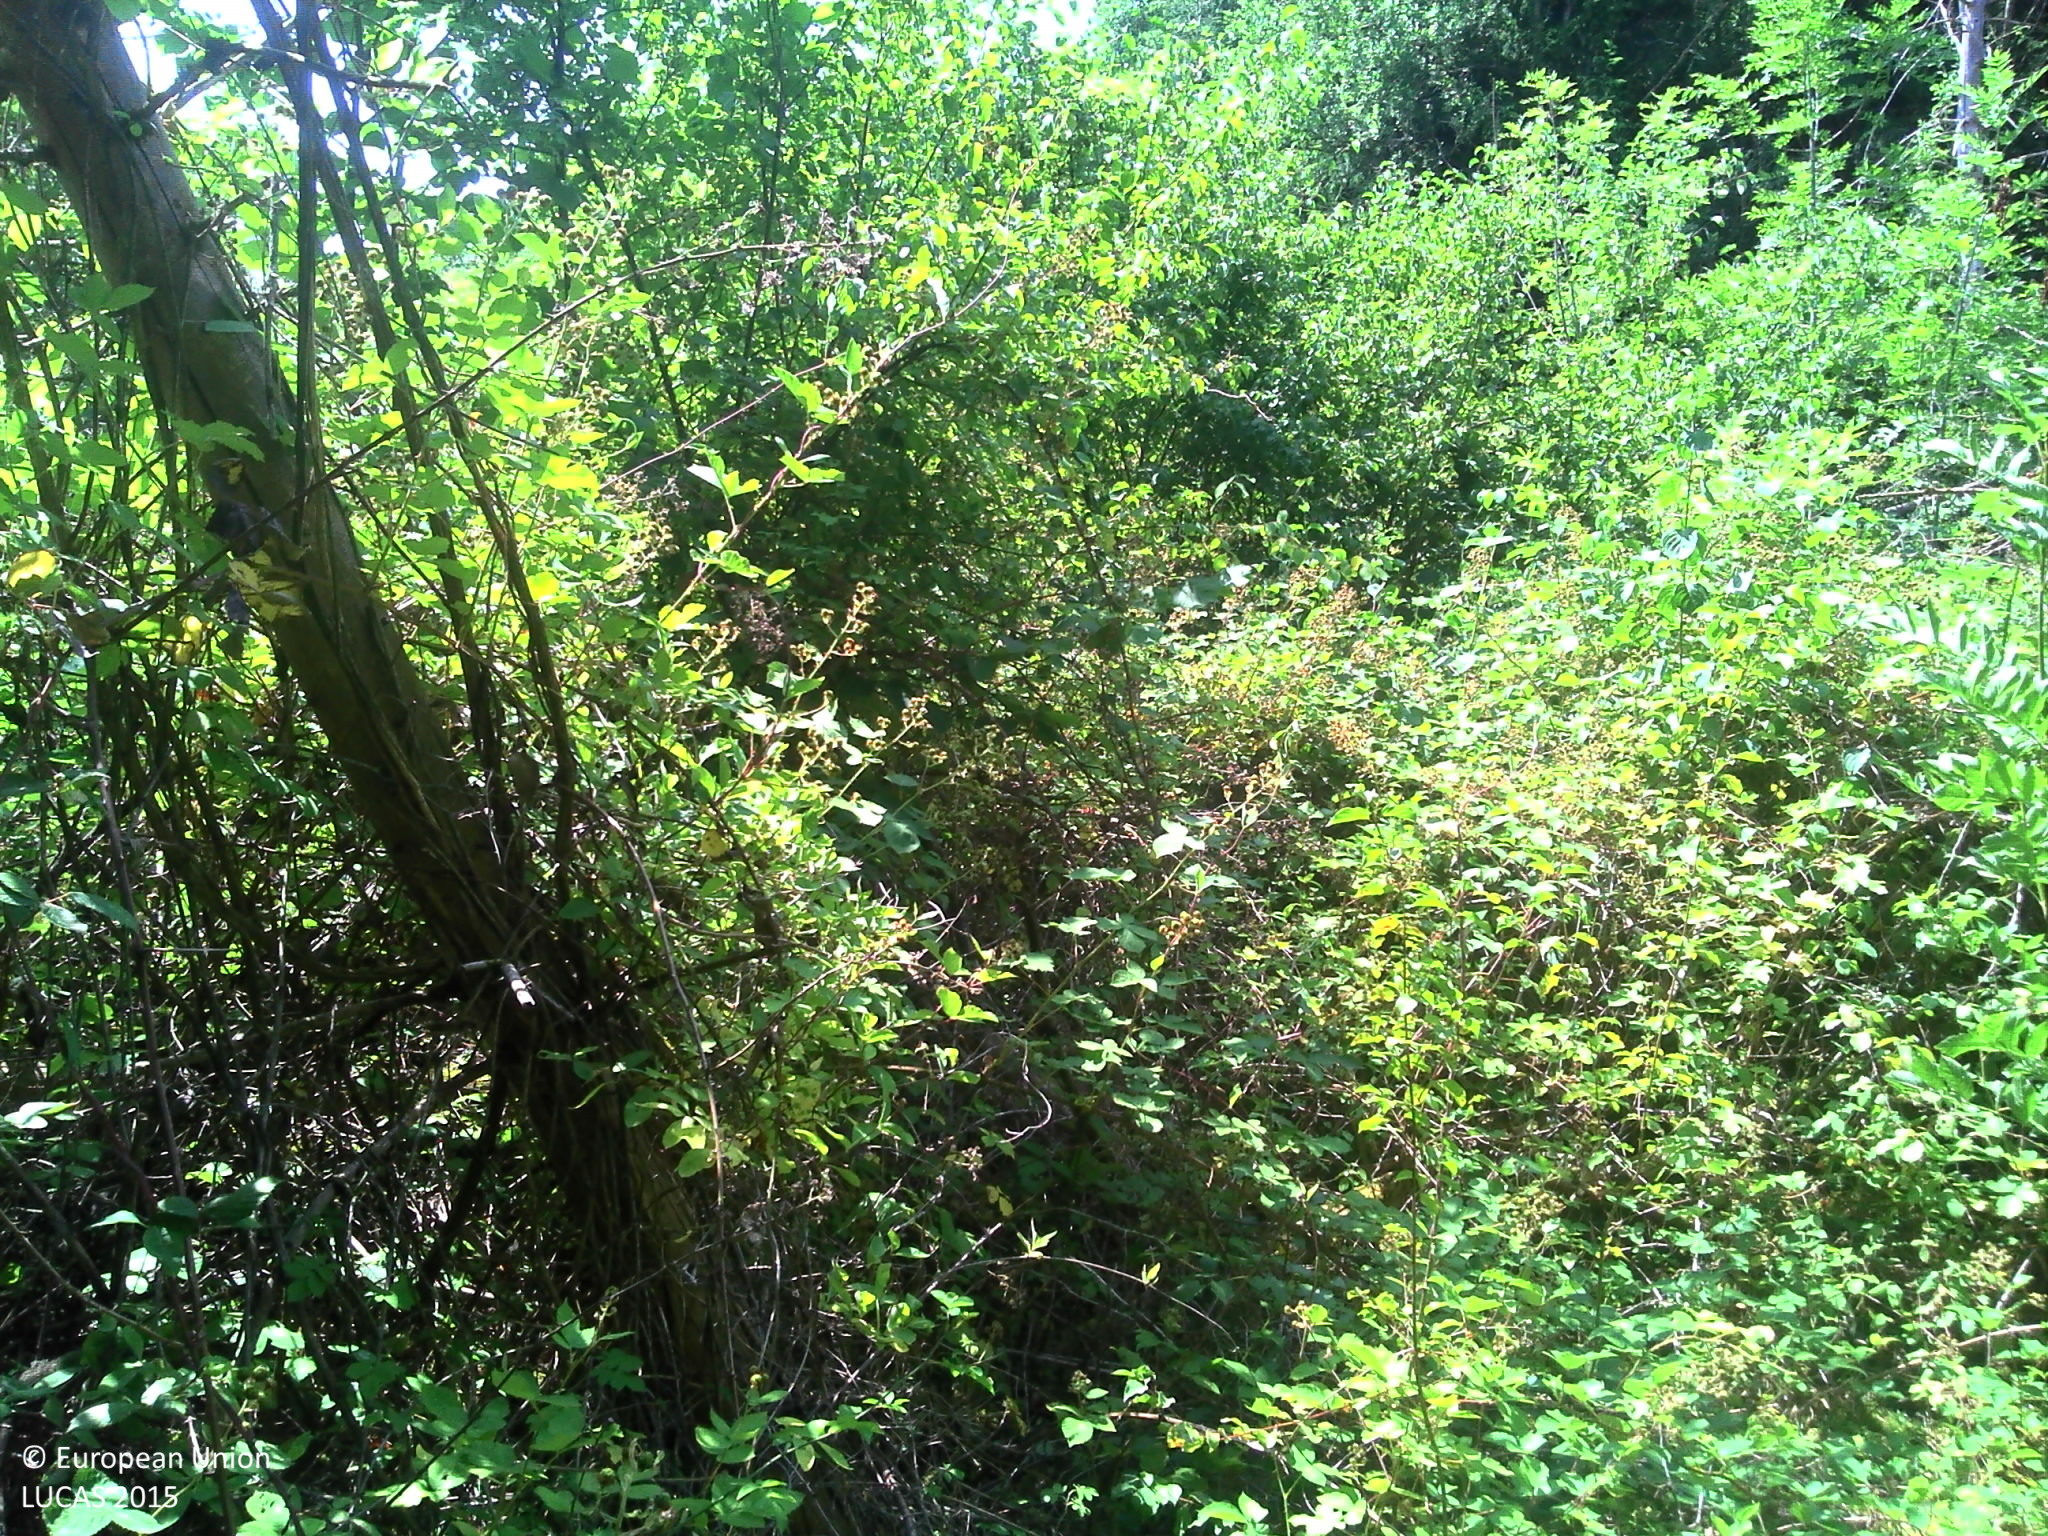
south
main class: Woodland
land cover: Spruce dominated mixed woodland
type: mountainous beech forest
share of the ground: > 75 %
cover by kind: coniferous forest trees 30 %, broadleaved forest trees 30 %, shrubs 15 %, herbaceous plants 15 %, lichens and mosses 10 %
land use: Forestry
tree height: > 5 m
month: July
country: FR
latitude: 46.1417
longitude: 6.2623
